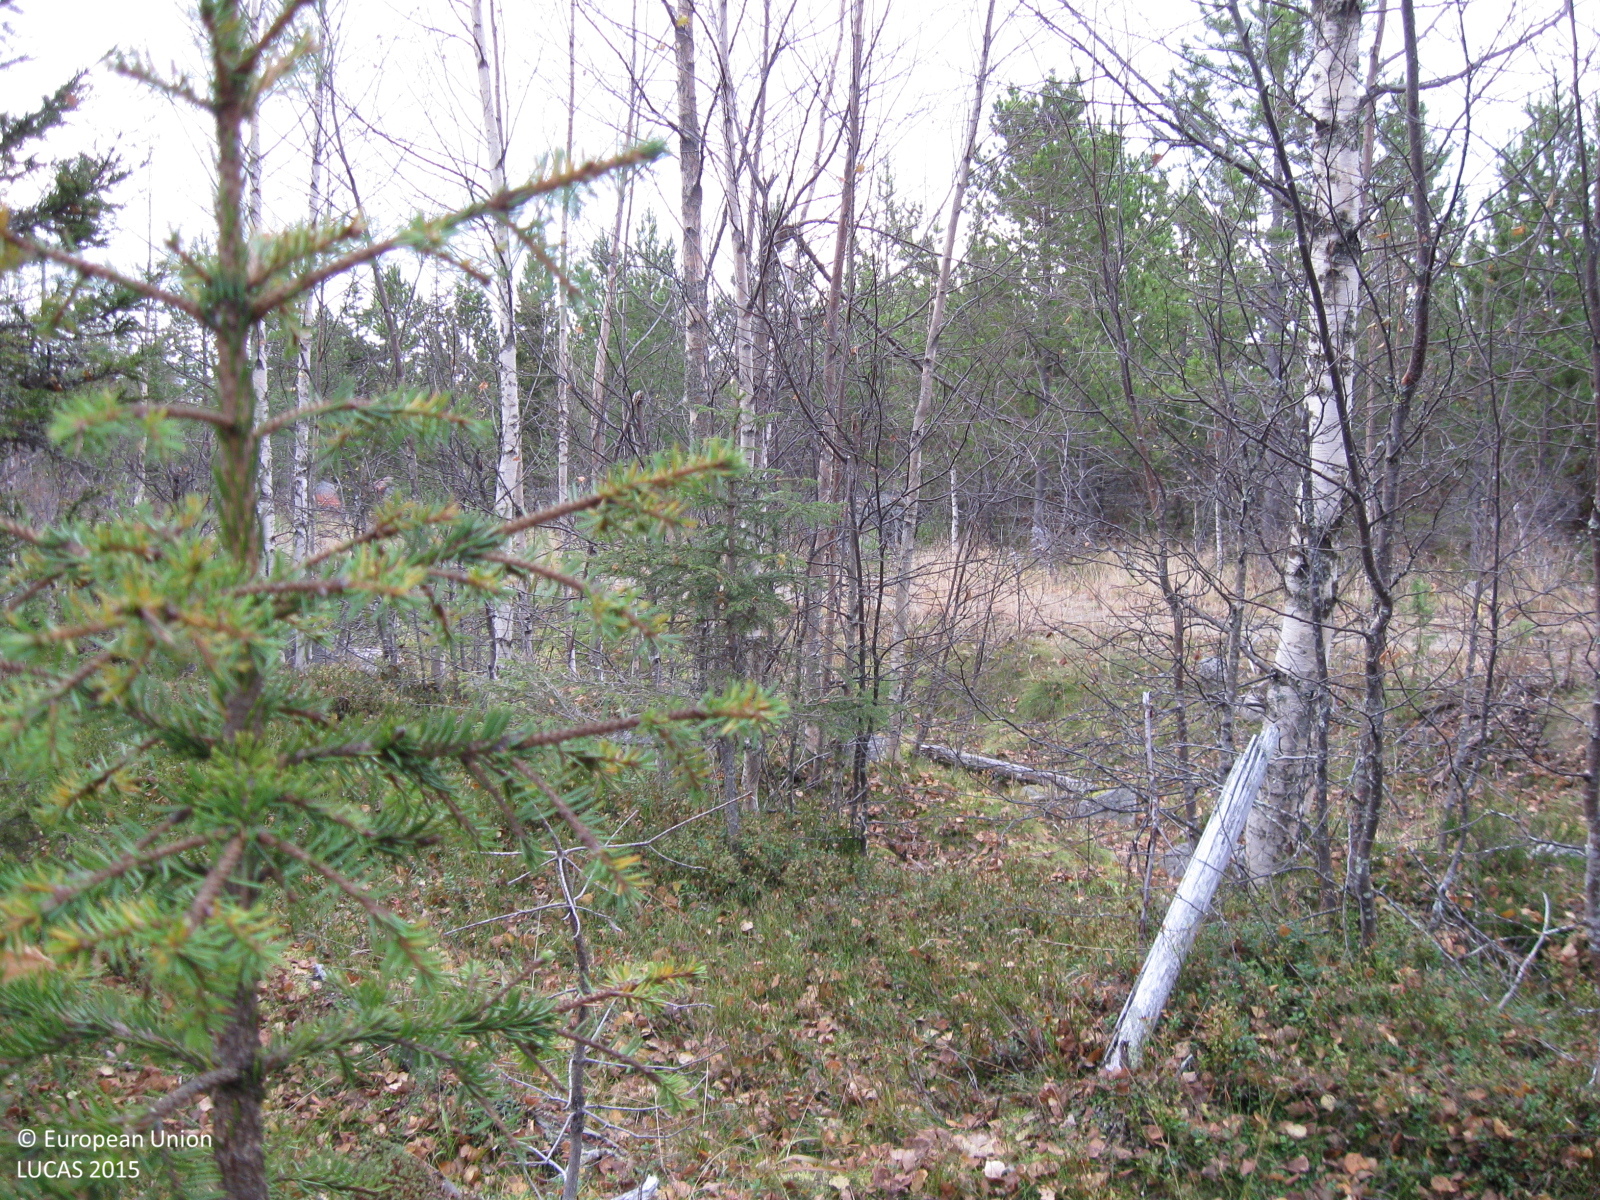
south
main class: Woodland
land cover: Pine dominated coniferous woodland
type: exotic forest
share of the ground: > 75 %
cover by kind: coniferous forest trees 80 %, broadleaved forest trees 5 %, herbaceous plants 5 %, lichens and mosses 5 %, unconsolidated bare surface 5 %
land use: Forestry
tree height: > 5 m
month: October
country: SE
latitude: 66.1070
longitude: 22.2094
